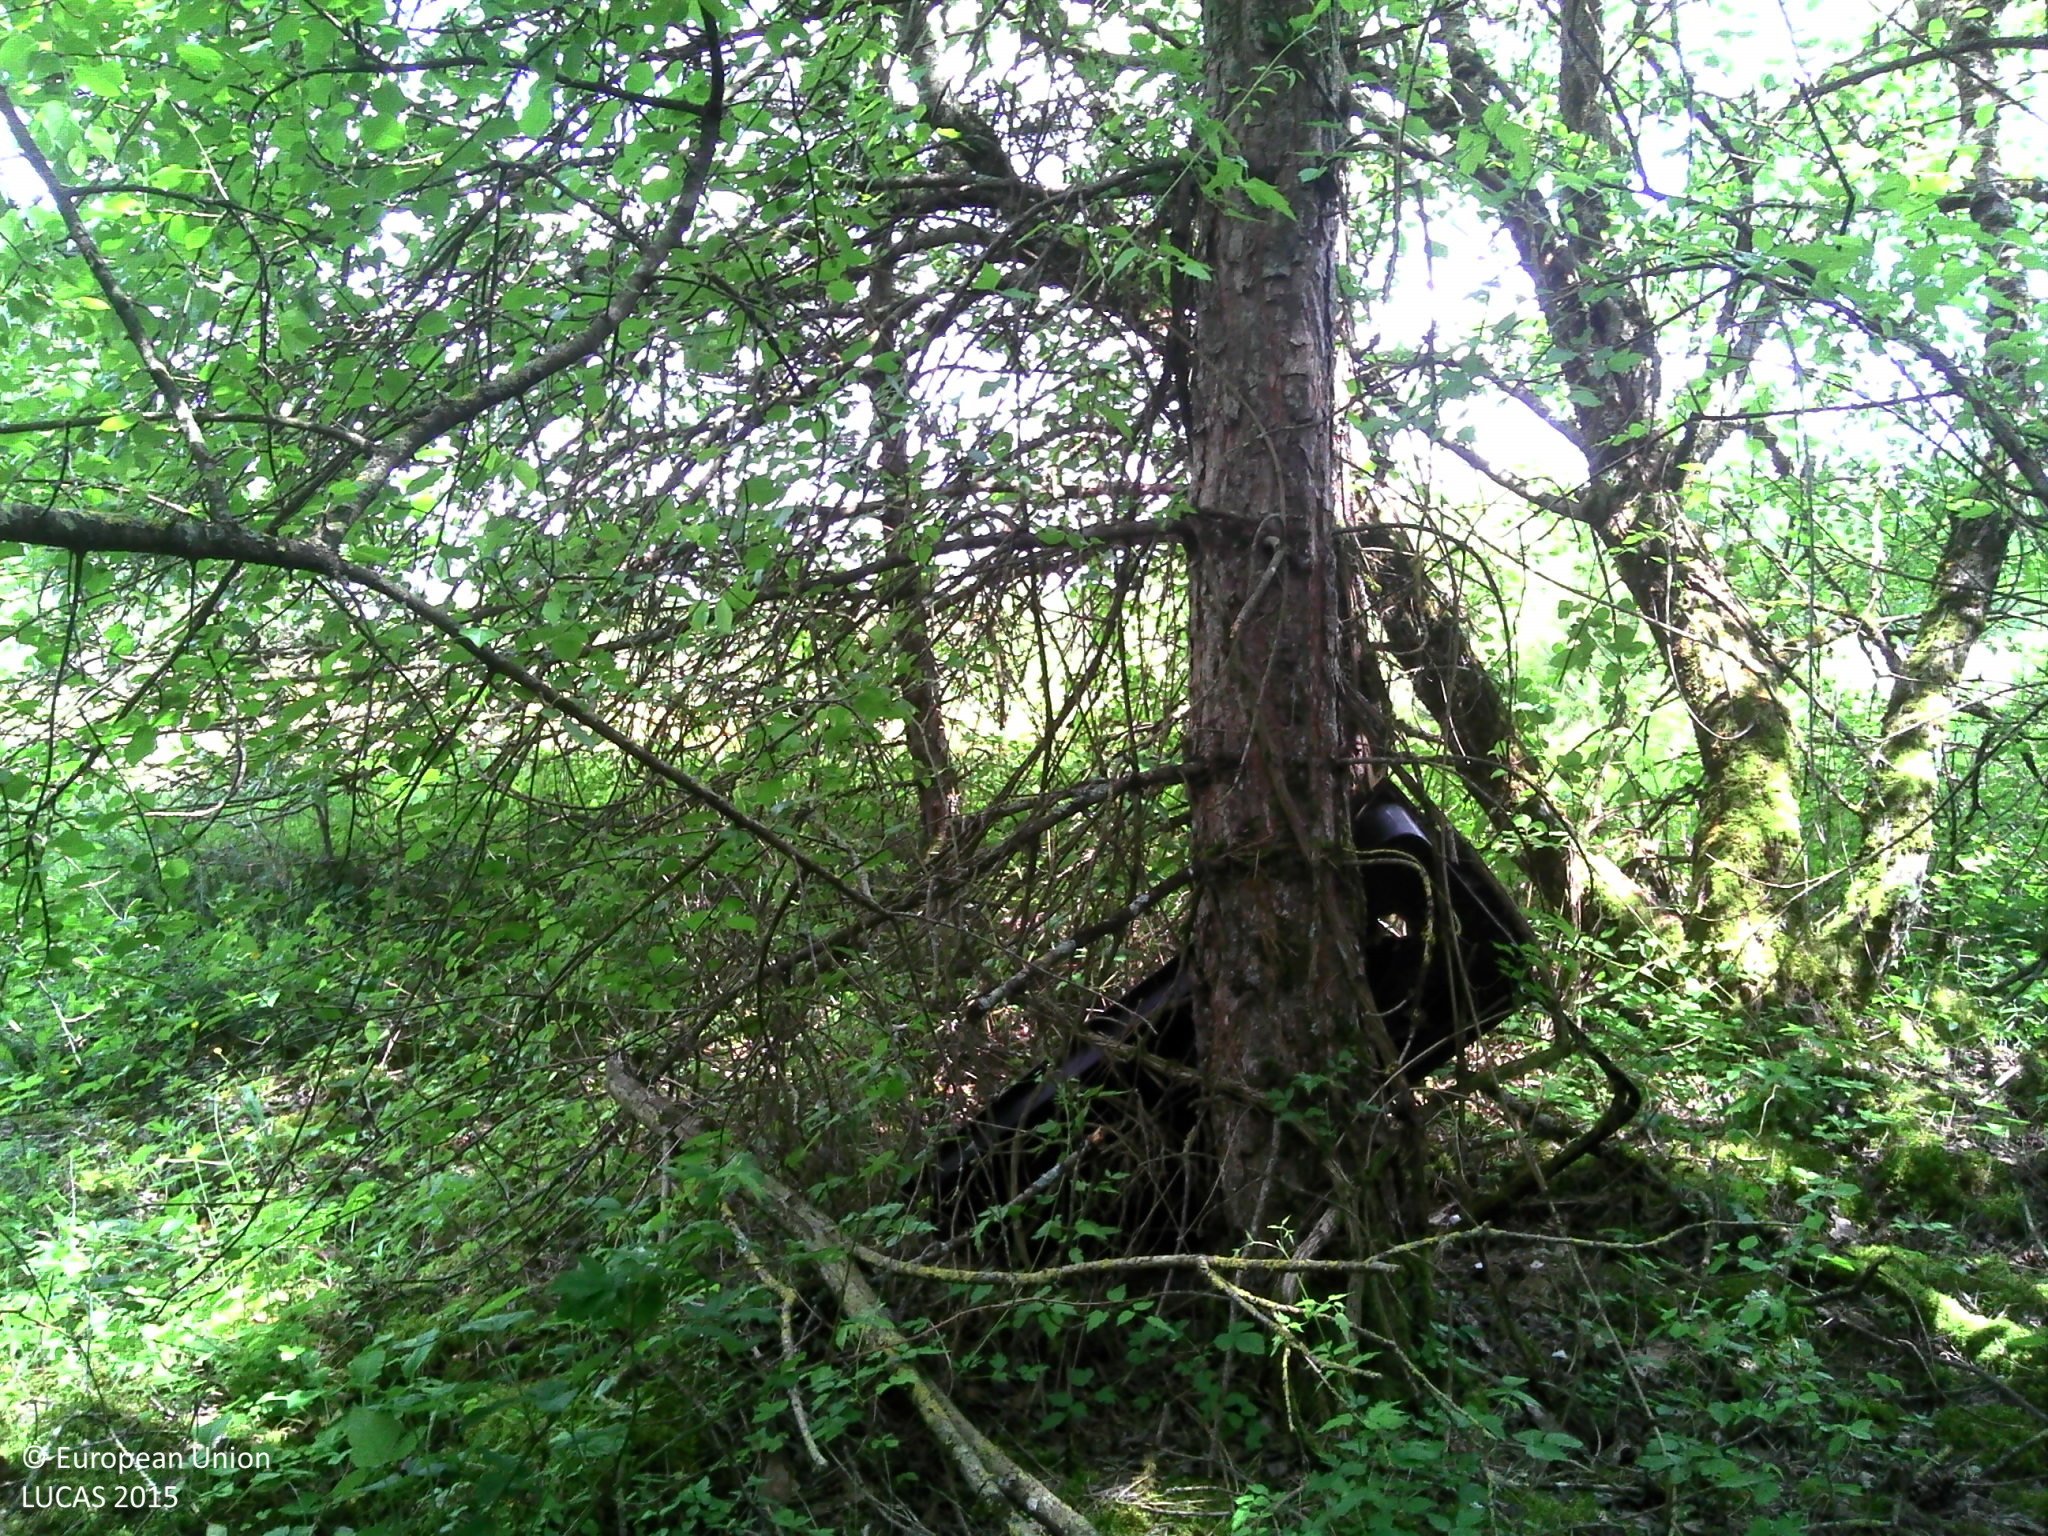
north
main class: Woodland
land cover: Pine dominated mixed woodland
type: exotic forest
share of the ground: > 75 %
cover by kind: coniferous forest trees 60 %, broadleaved forest trees 30 %, herbaceous plants 5 %, lichens and mosses 5 %
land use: Forestry
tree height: > 5 m
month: May
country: FR
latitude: 47.7135
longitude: 3.9323
